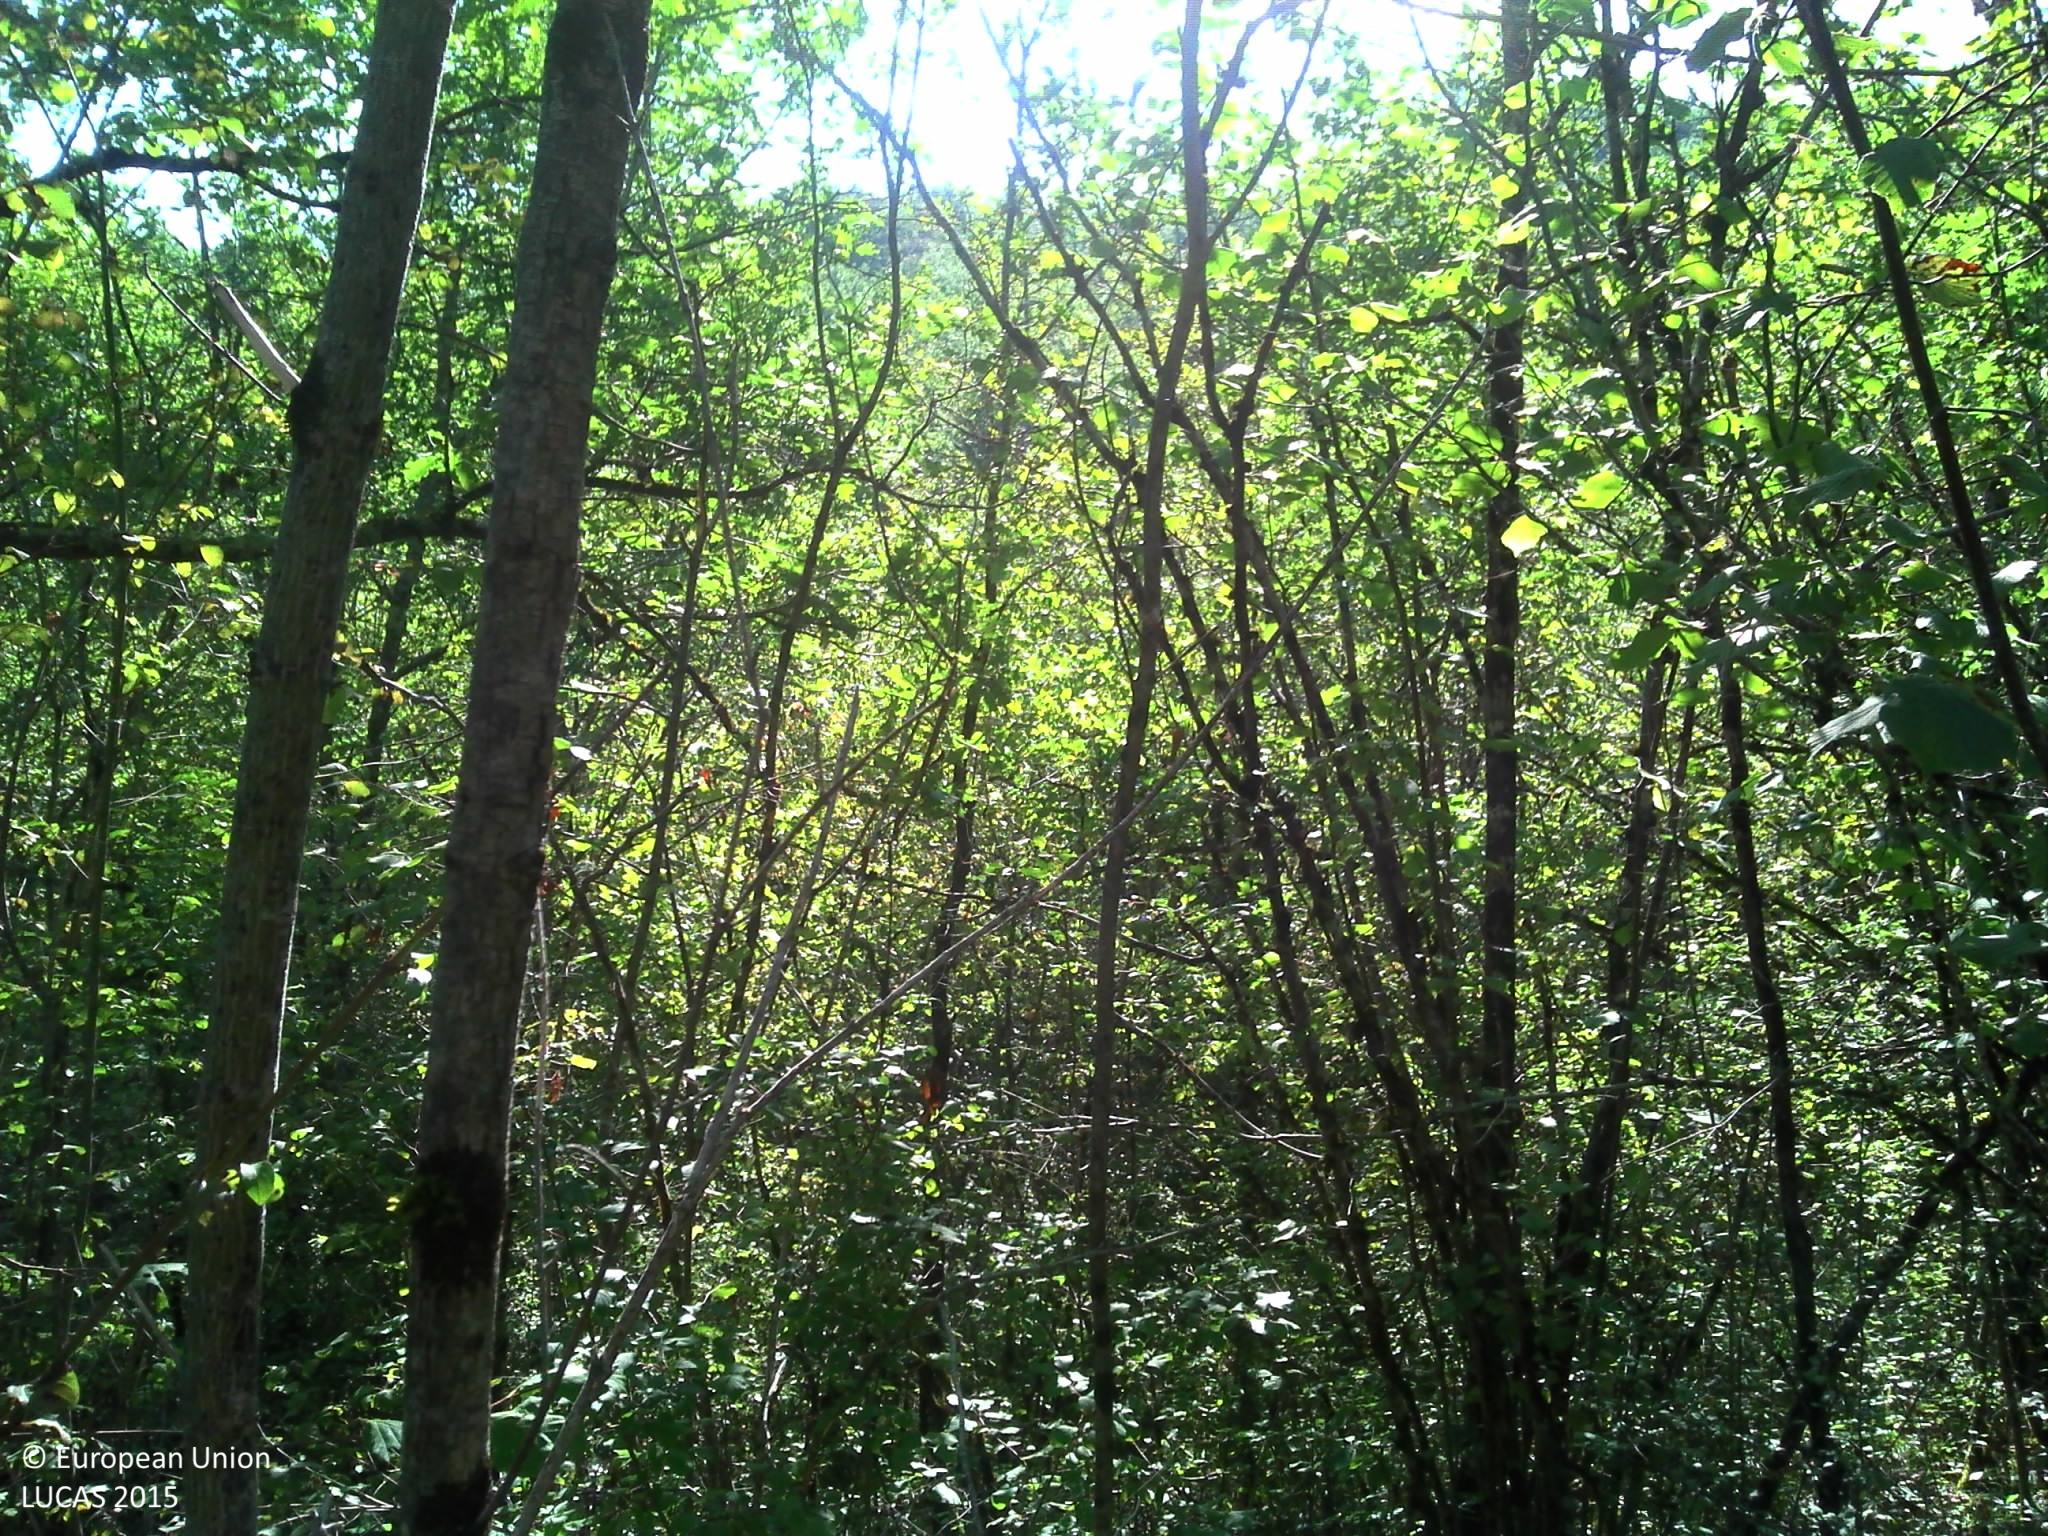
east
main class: Woodland
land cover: Broadleaved woodland
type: thermophilous deciduous forest
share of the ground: > 75 %
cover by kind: broadleaved forest trees 60 %, shrubs 20 %, herbaceous plants 20 %
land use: Forestry
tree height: > 5 m
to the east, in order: Broadleaved woodland; Dry stone walls; Broadleaved woodland; Grass margins; Tracks; Grass margins; Broadleaved woodland; Grassland with sparse tree/shrub cover; Broadleaved woodland; Grassland with sparse tree/shrub cover; Broadleaved woodland
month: September
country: FR
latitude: 44.6697
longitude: 1.2548
